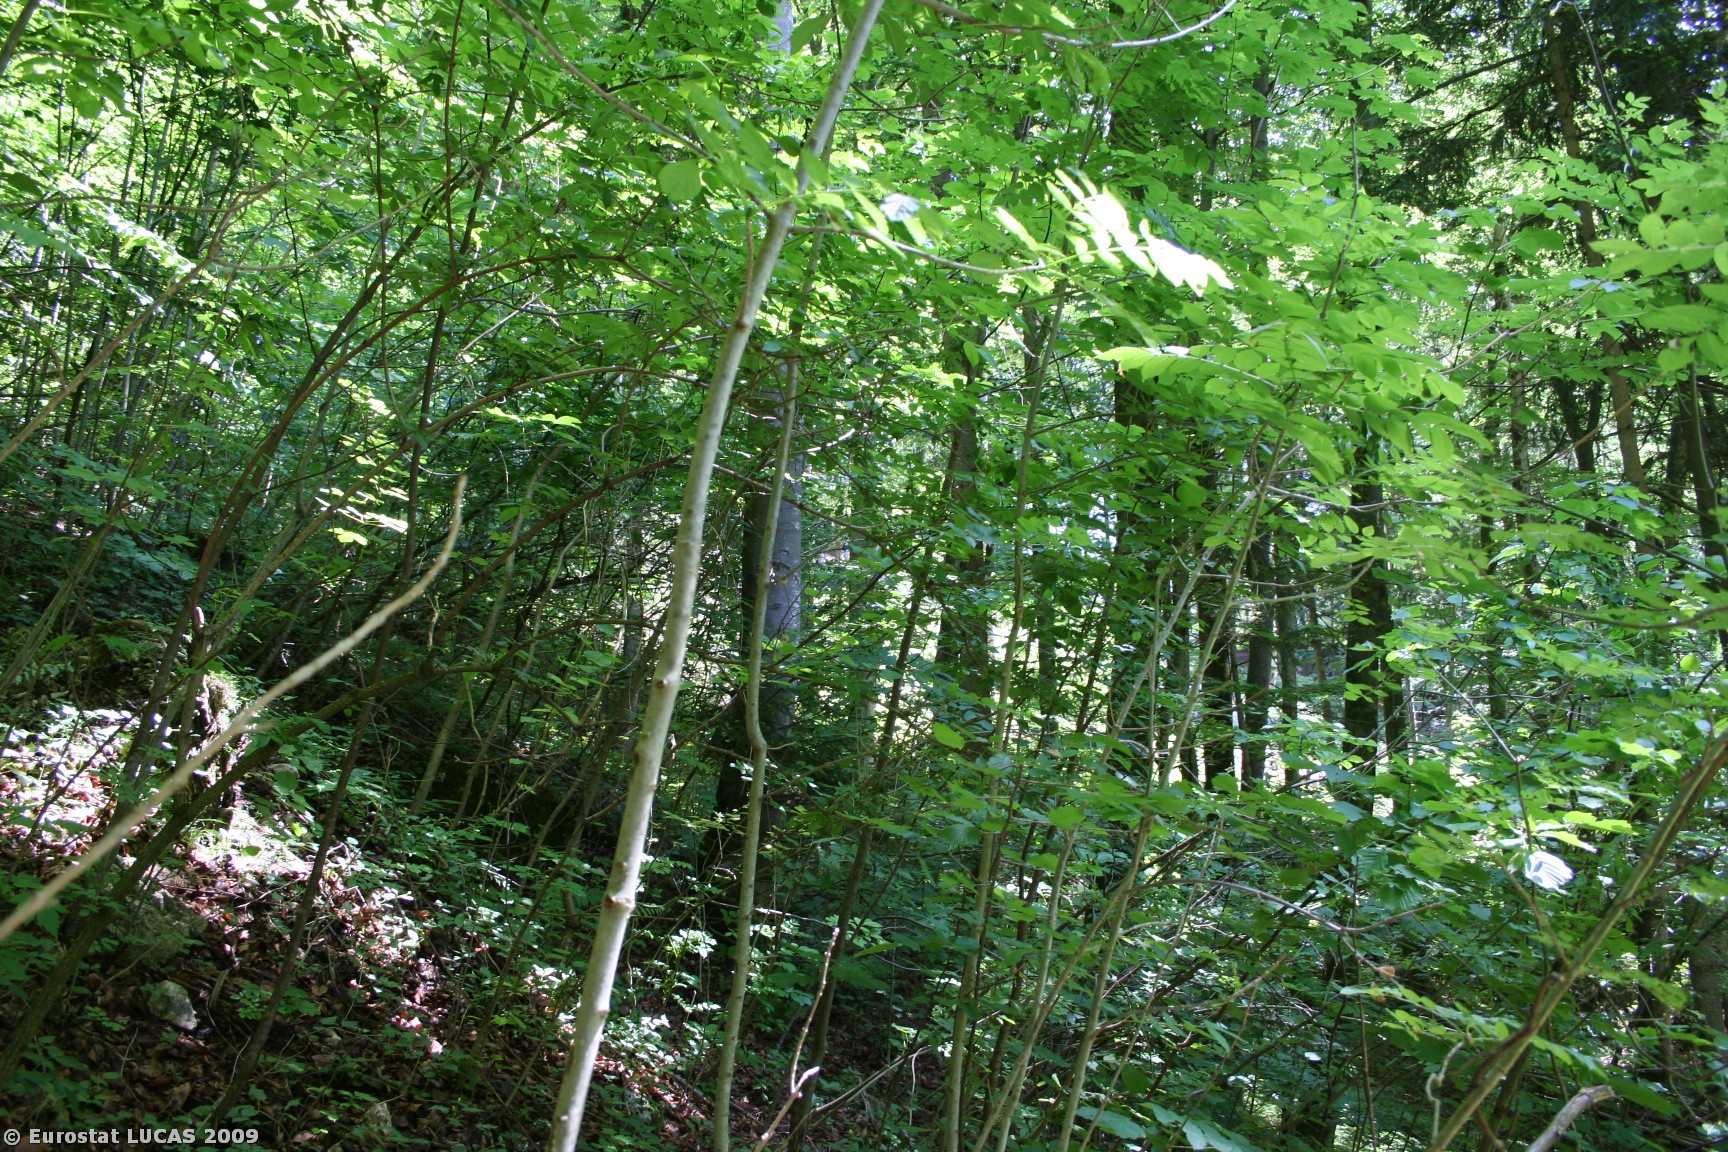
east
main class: Woodland
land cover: Mixed woodland
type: hemiboreal forest and nemoral coniferous forest and mixed broadleaved-coniferous forest
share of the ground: > 75 %
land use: Forestry
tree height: > 5 m
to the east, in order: Mixed woodland; Tracks; Broadleaved woodland; Mixed woodland; Tracks; Mixed woodland; Ditches and canals; Mixed woodland
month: May
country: AT
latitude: 47.6007
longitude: 13.2039
